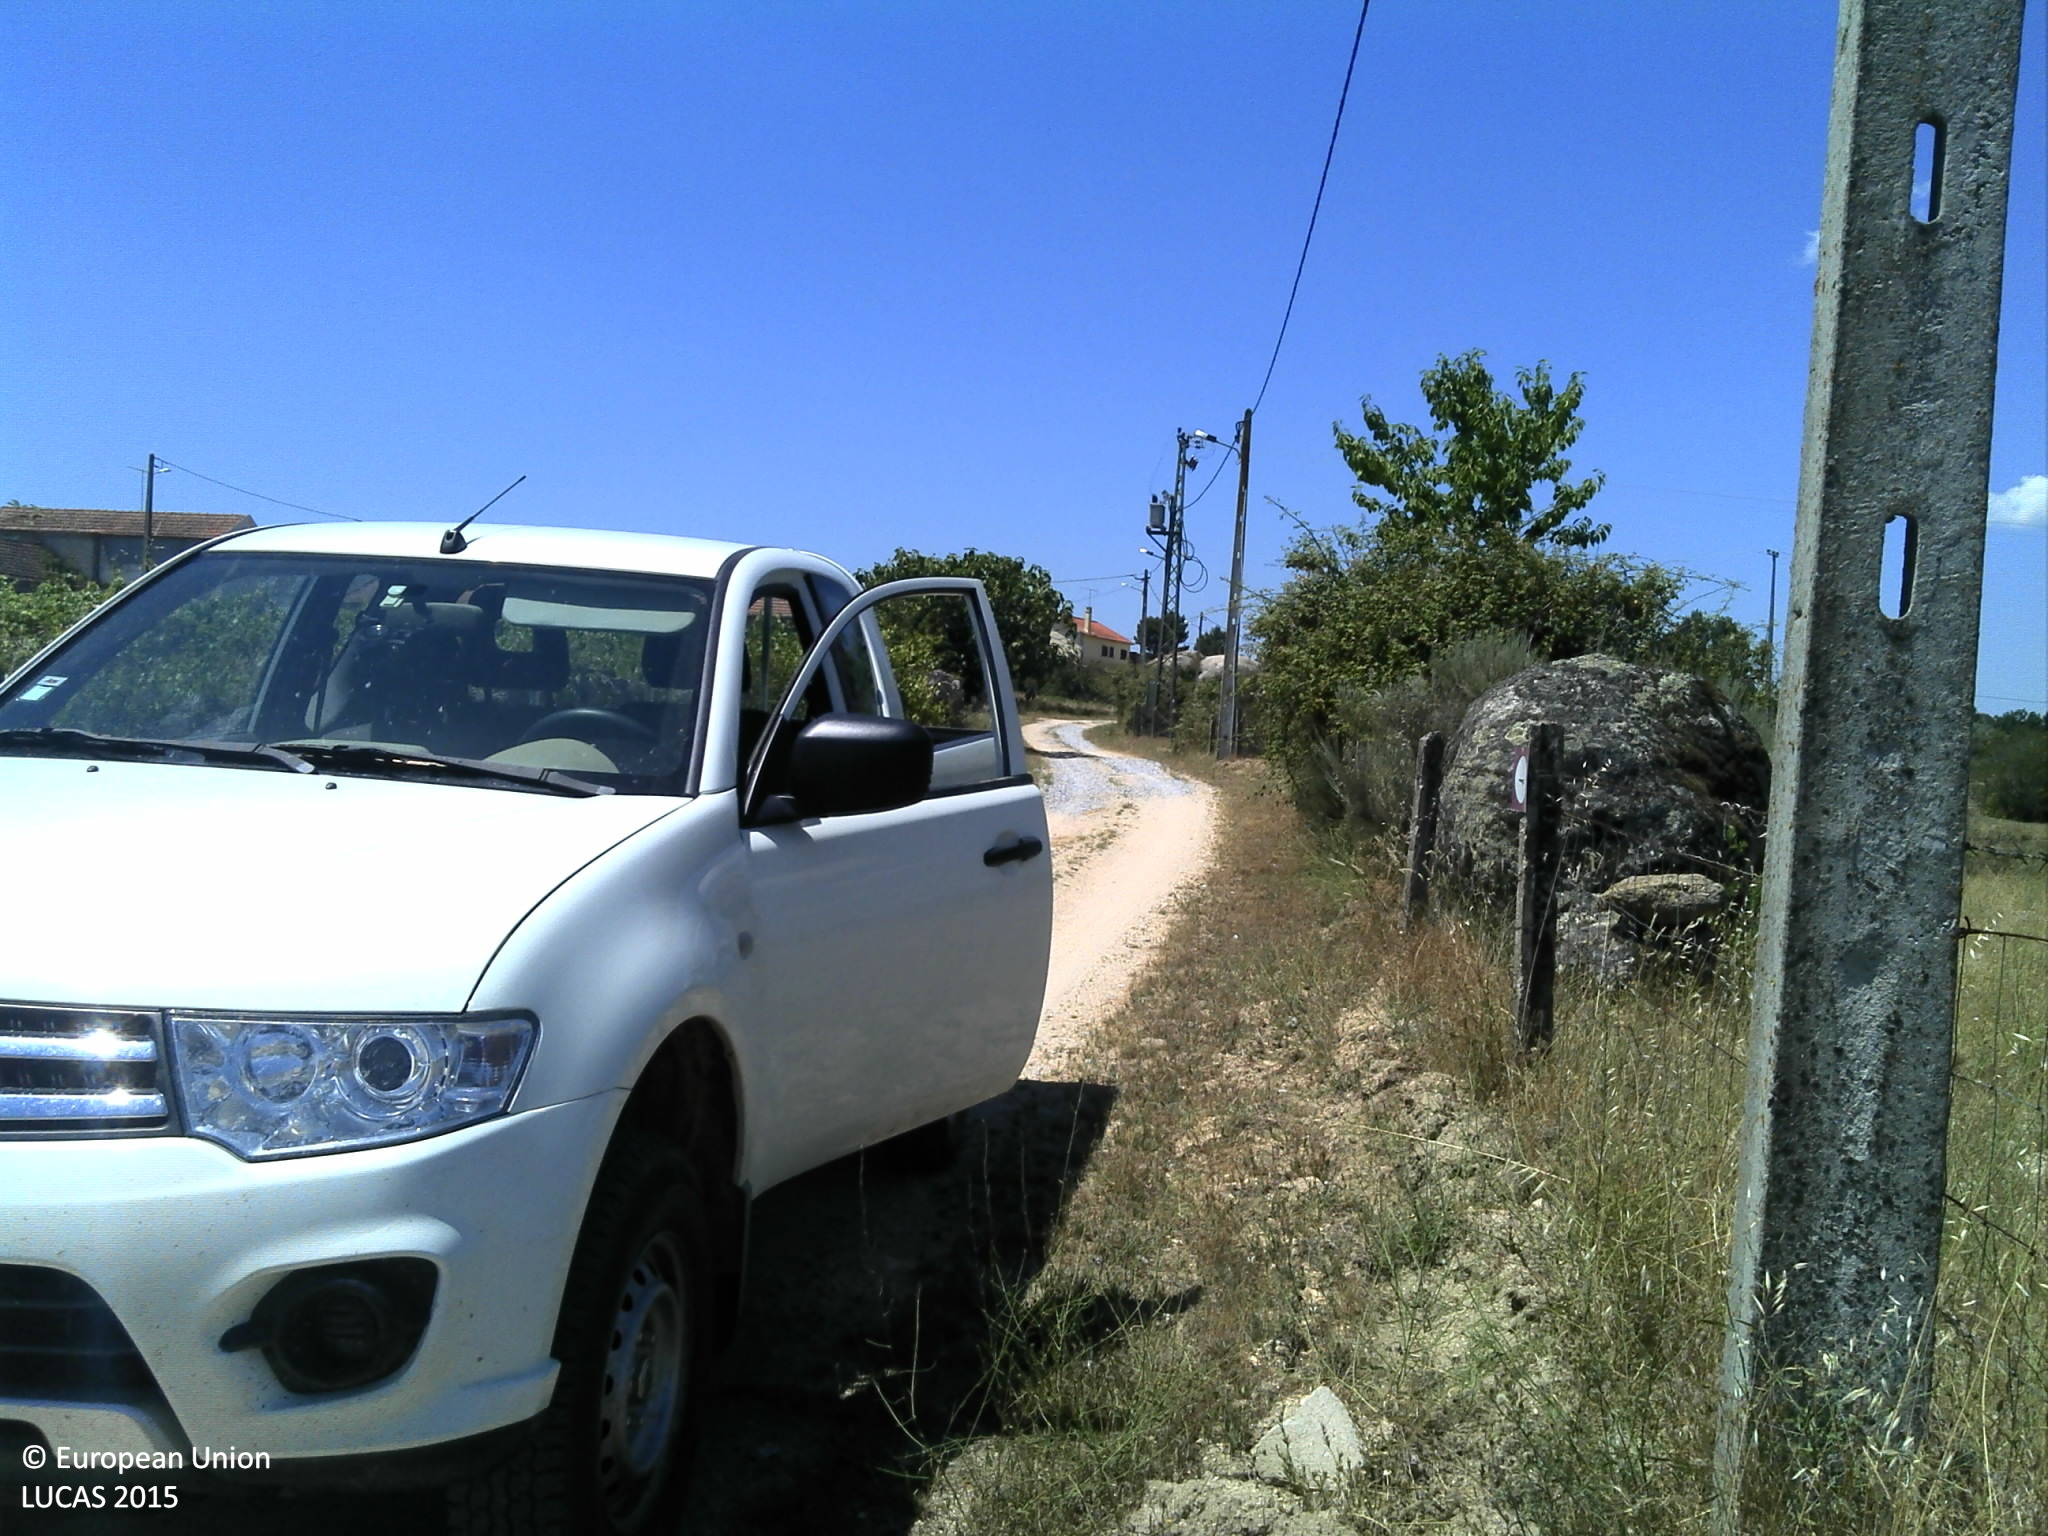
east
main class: Grassland
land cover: Grassland without tree/shrub cover
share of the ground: > 75 %
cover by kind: herbaceous plants 80 %, unconsolidated bare surface 20 %
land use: Agriculture (excluding fallow land and kitchen gardens)
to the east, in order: Grassland without tree/shrub cover; Broadleaved woodland; Grassland without tree/shrub cover; Shrubland with sparse tree cover; Grassland without tree/shrub cover; Abandoned hedges; Ditches and canals; Grassland without tree/shrub cover
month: June
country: PT
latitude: 40.7327
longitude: -7.1692
